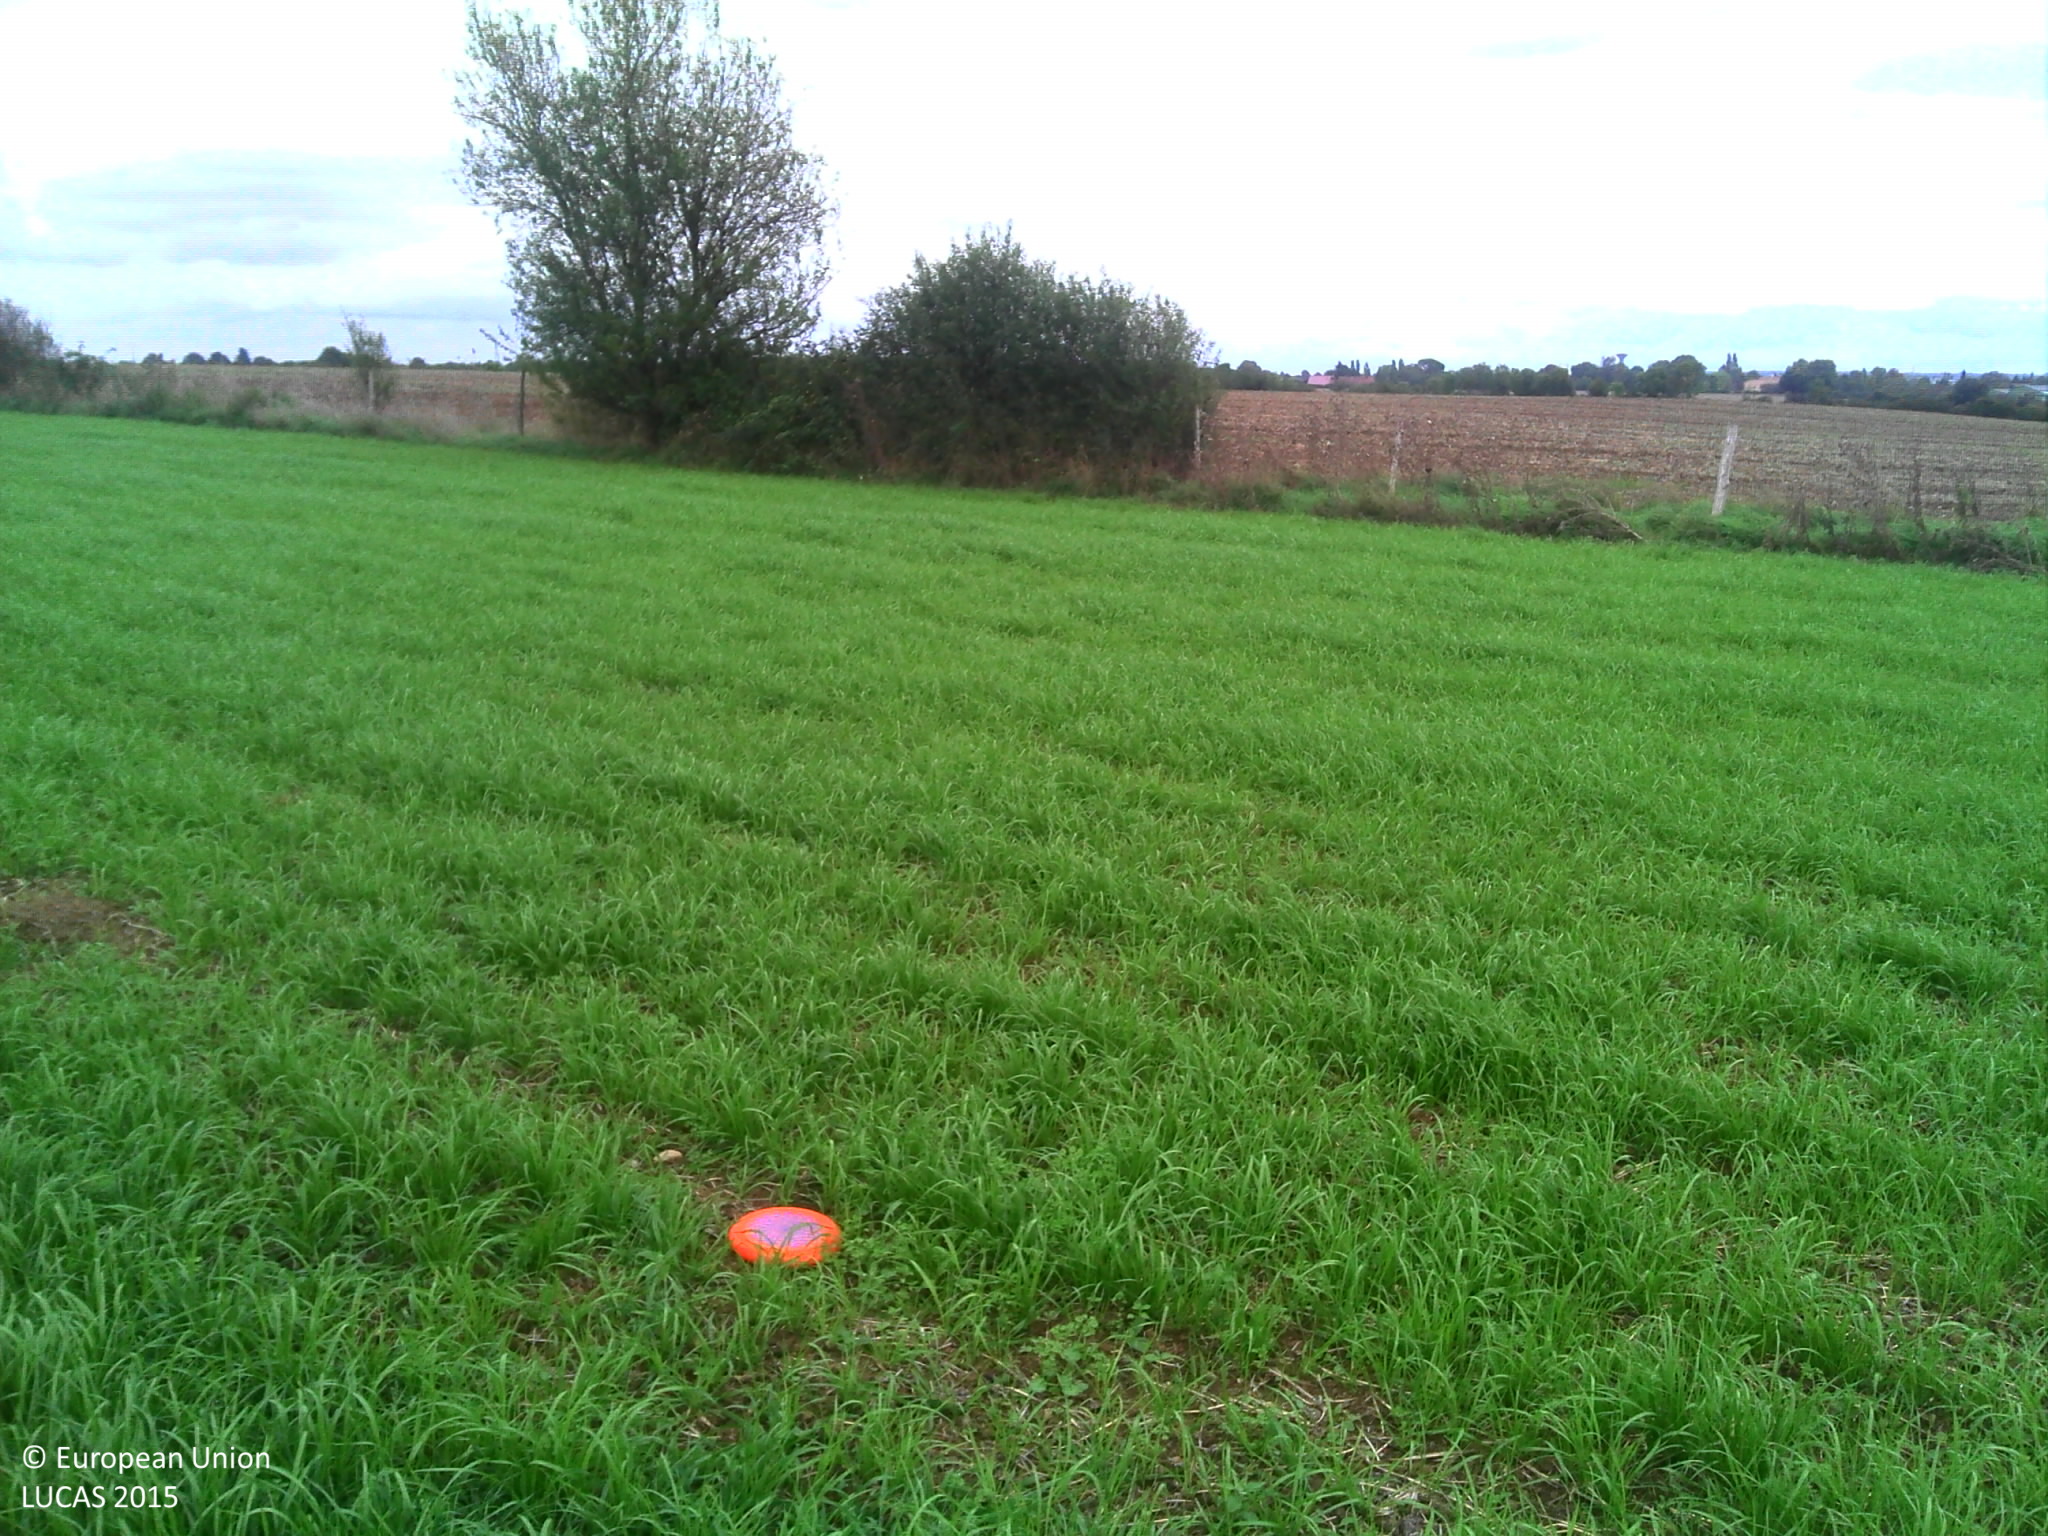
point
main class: Cropland
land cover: Temporary grasslands
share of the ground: > 75 %
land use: Agriculture (excluding fallow land and kitchen gardens)
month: September
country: FR
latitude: 46.7204
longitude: -1.0628
